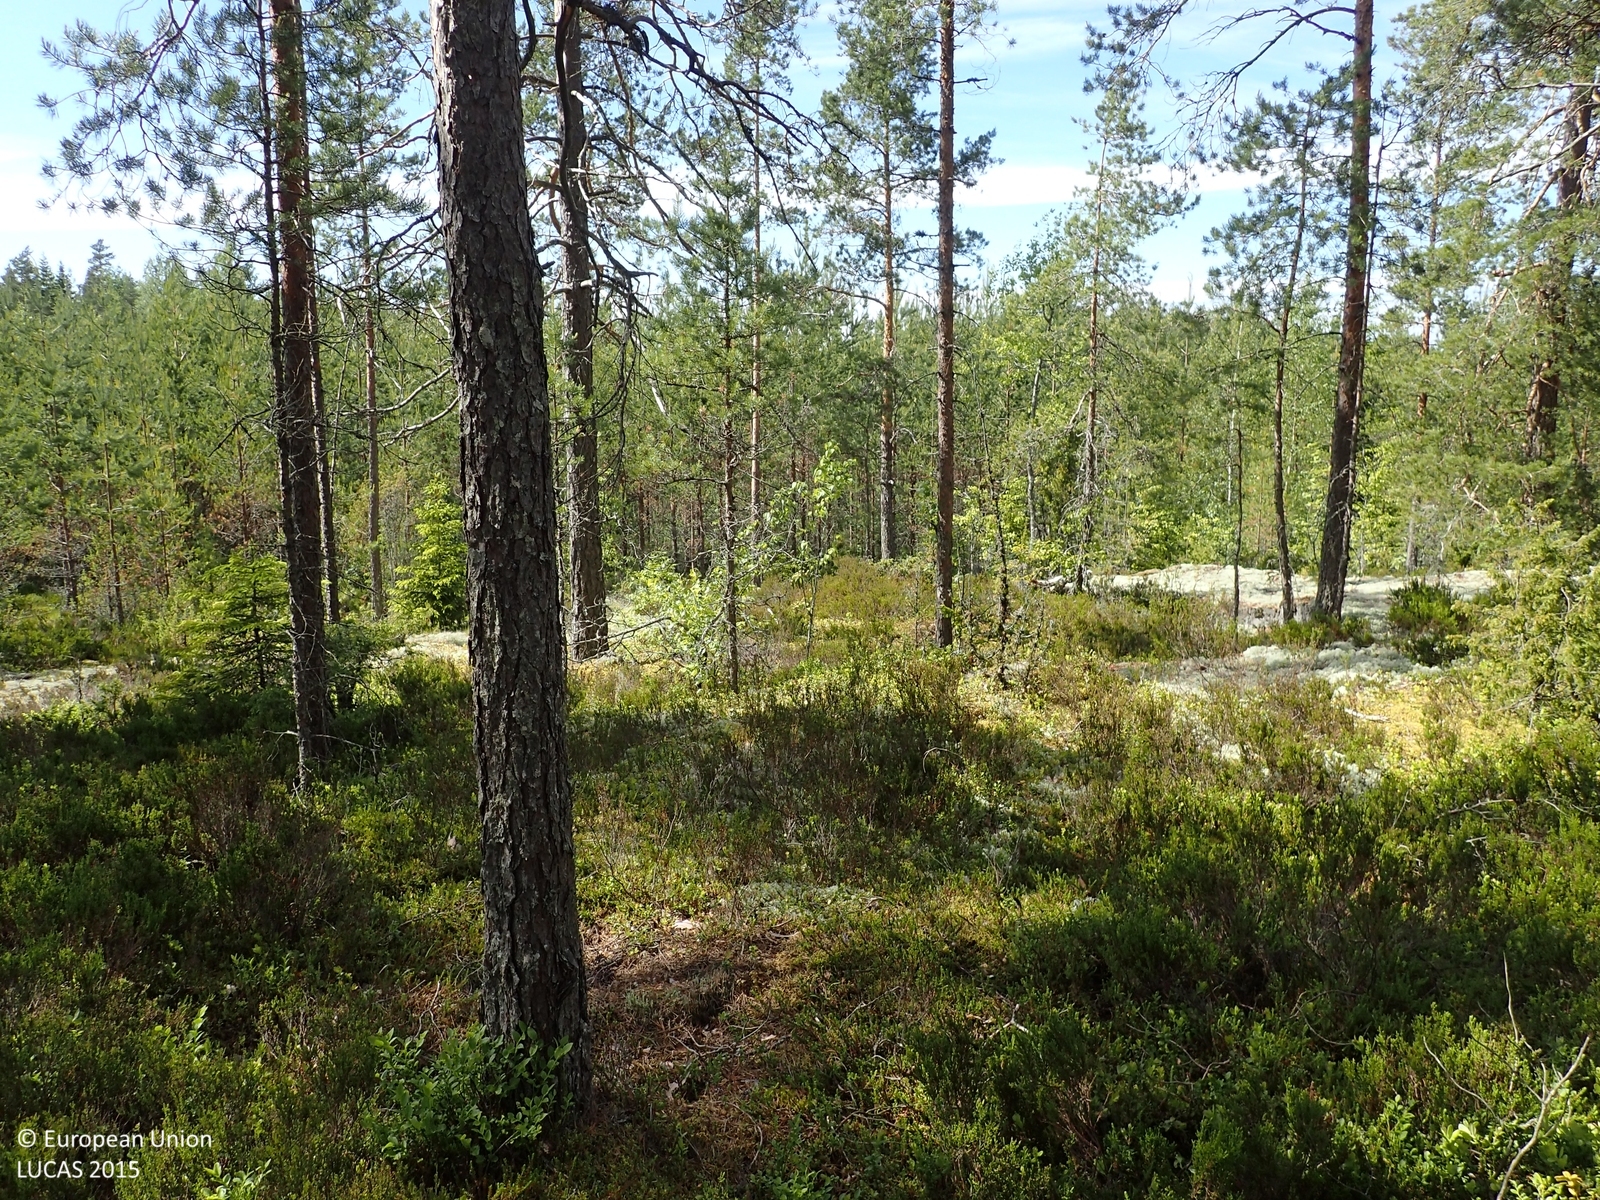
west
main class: Woodland
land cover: Pine dominated coniferous woodland
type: boreal forest
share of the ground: 25 - 50 %
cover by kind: shrubs 50 %, coniferous forest trees 40 %, broadleaved forest trees 5 %, lichens and mosses 5 %
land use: Forestry
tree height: > 5 m
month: June
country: FI
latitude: 62.4327
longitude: 21.6475
